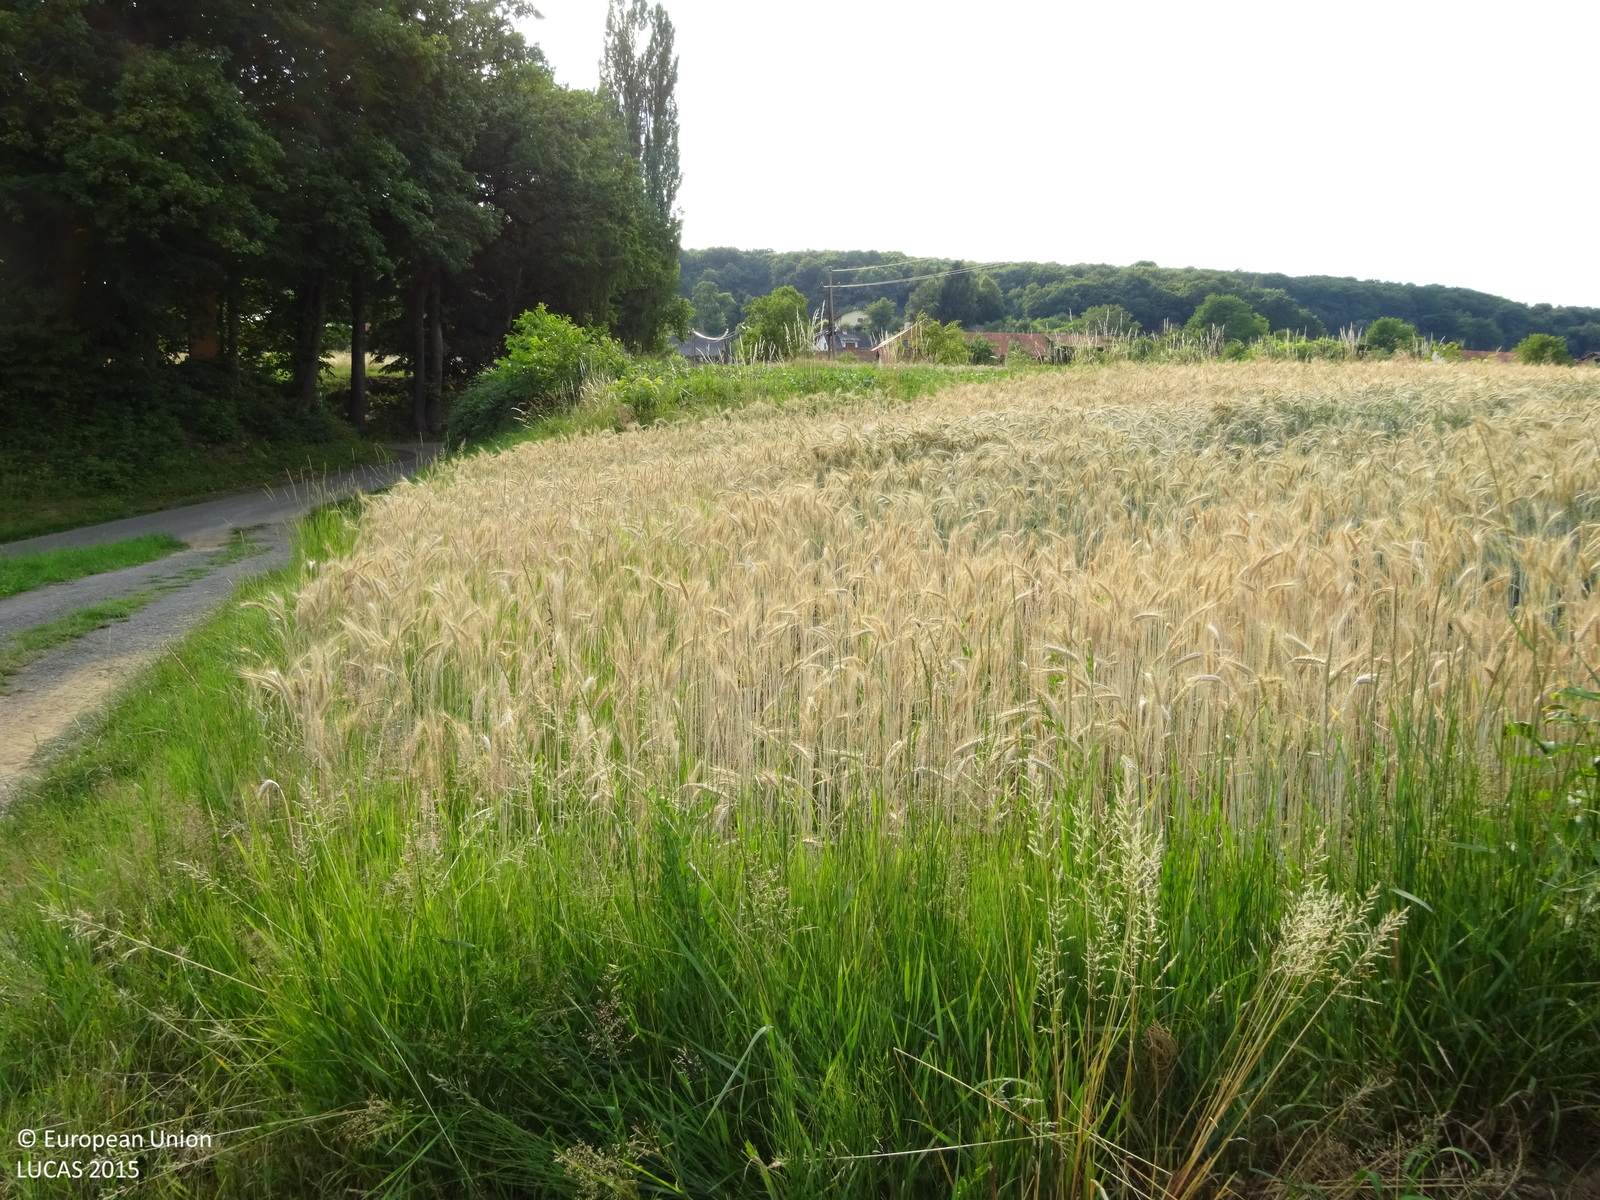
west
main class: Cropland
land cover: Apple fruit
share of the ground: > 75 %
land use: Agriculture (excluding fallow land and kitchen gardens)
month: June
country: AT
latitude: 46.8003
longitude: 15.9358
